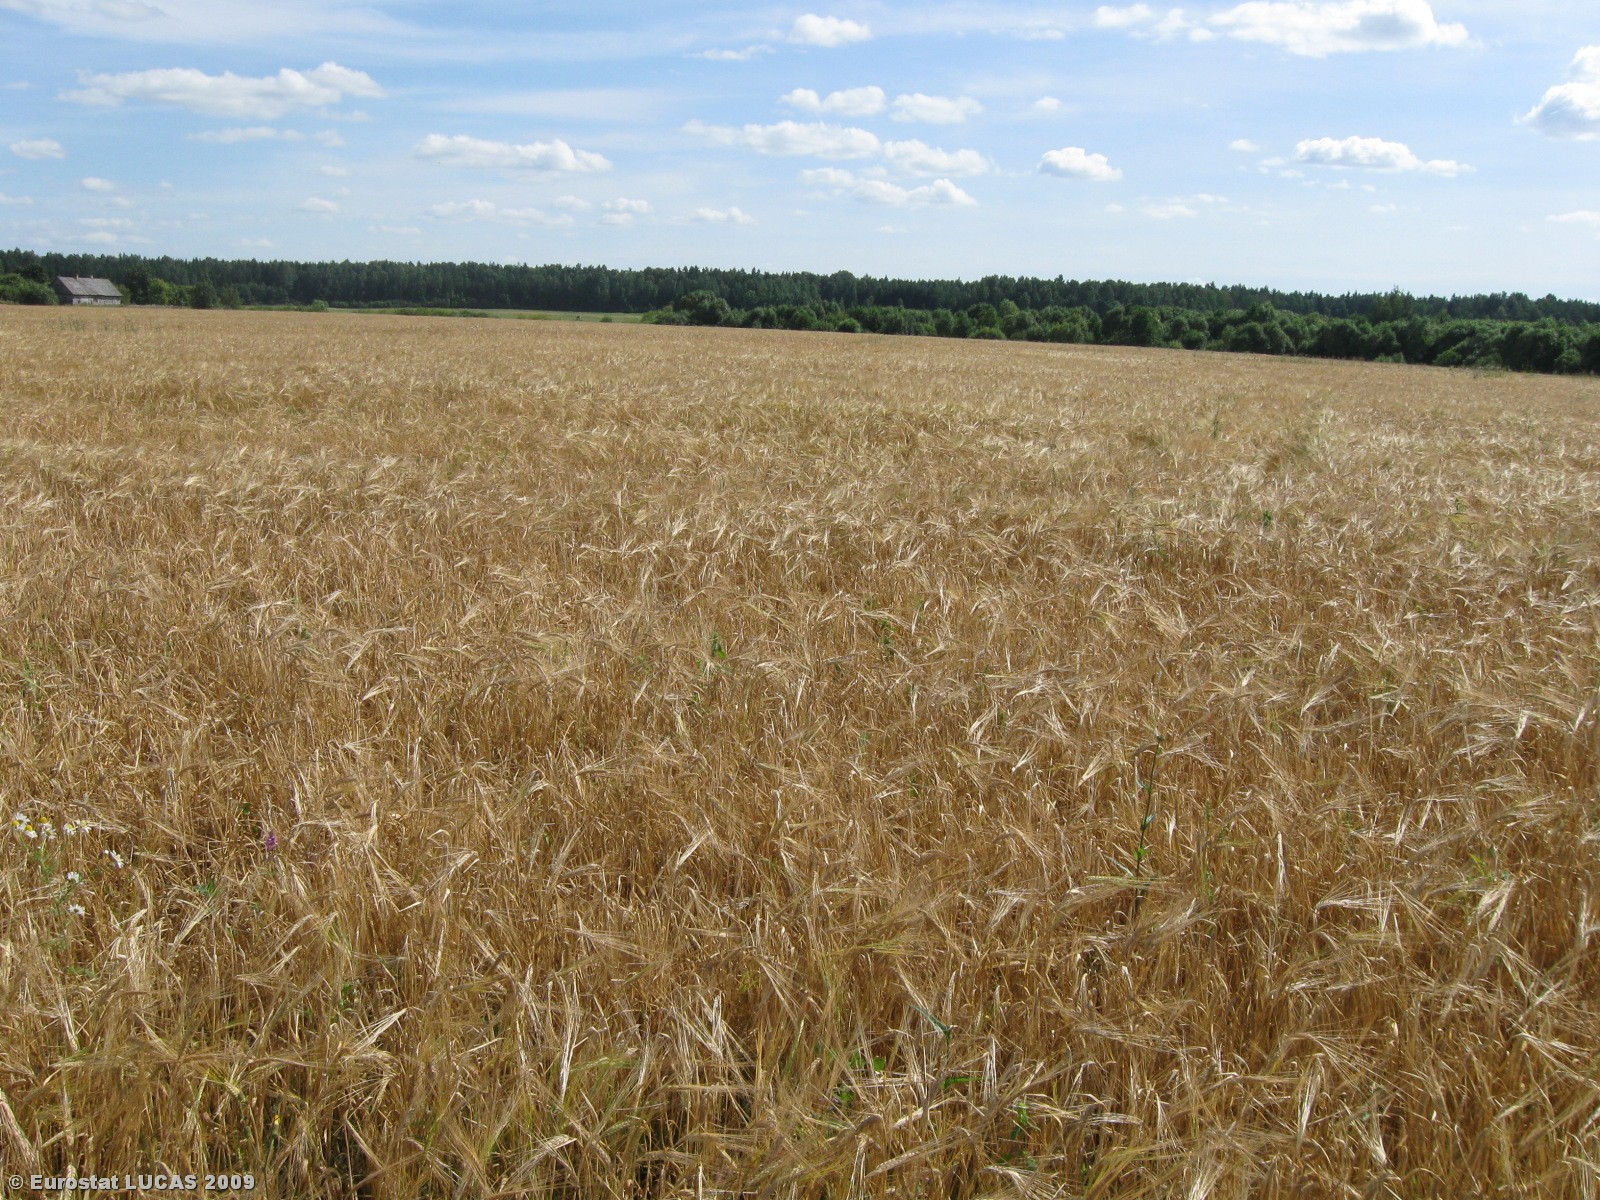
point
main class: Cropland
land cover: Barley
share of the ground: > 75 %
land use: Agriculture (excluding fallow land and kitchen gardens)
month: August
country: LT
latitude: 55.2088
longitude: 22.6840
